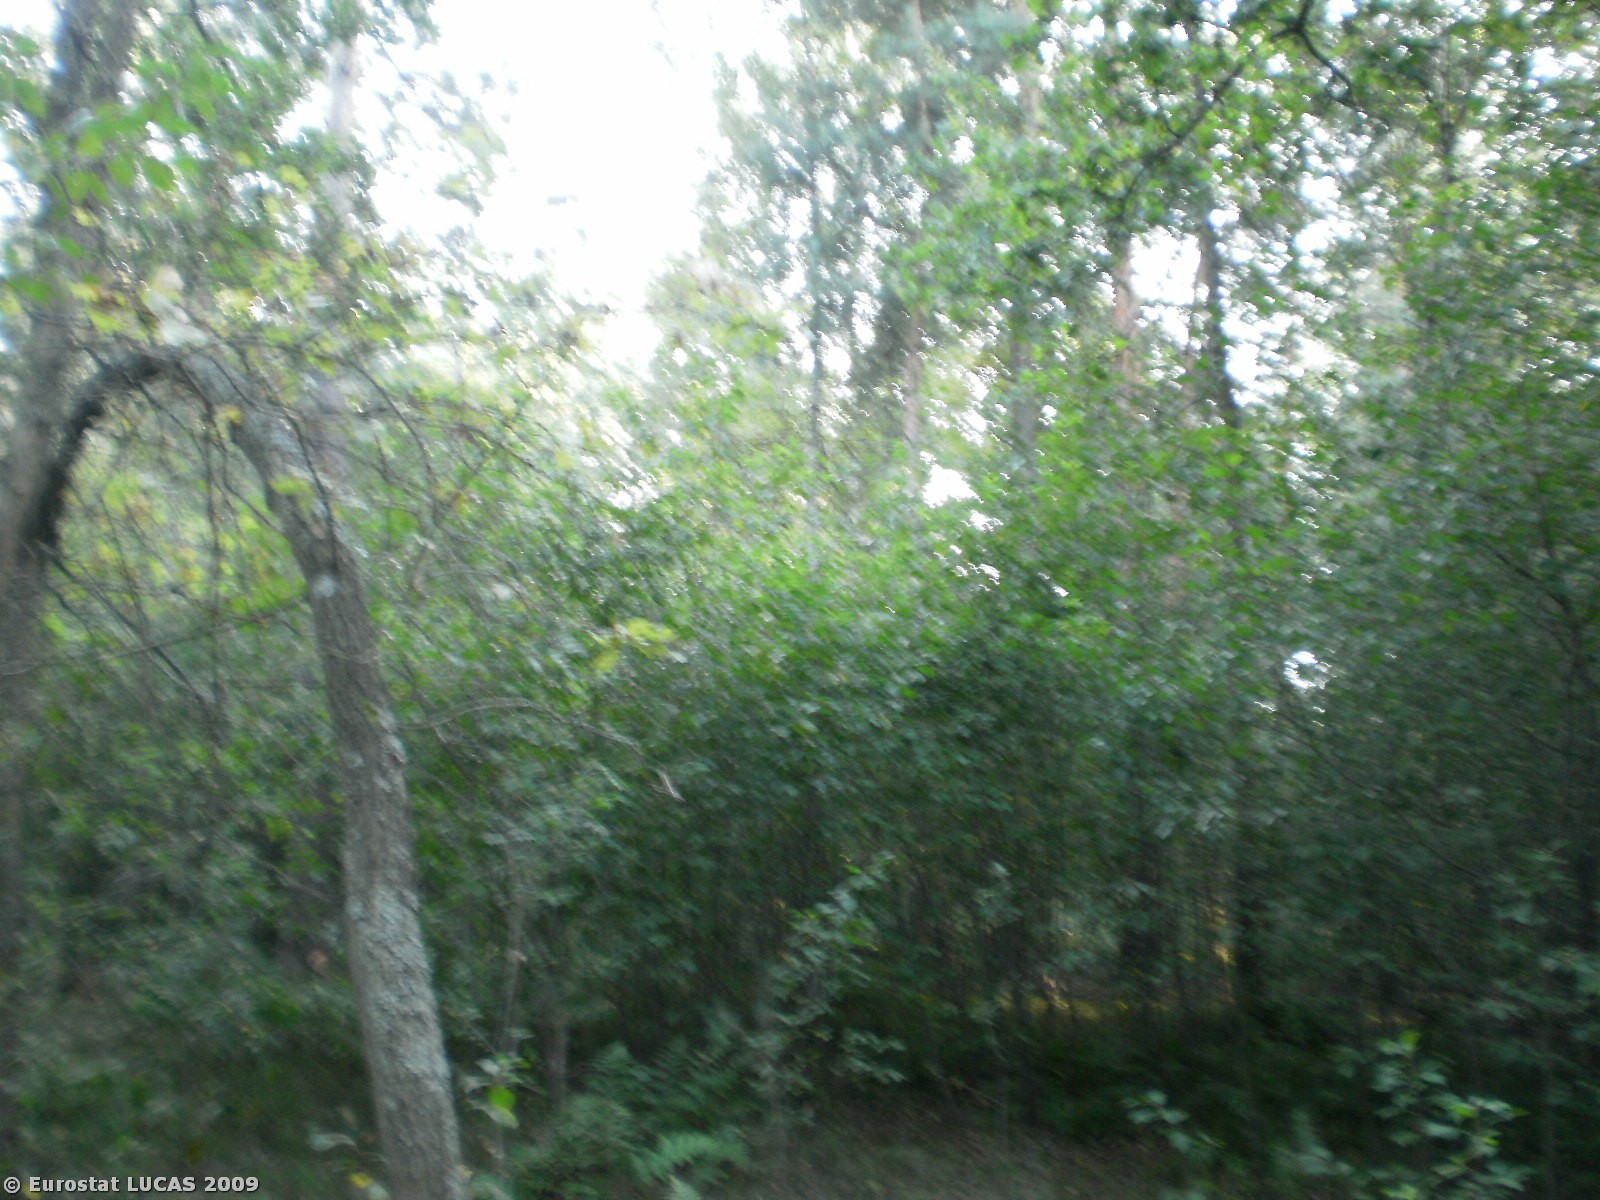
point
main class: Woodland
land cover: Mixed woodland
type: hemiboreal forest and nemoral coniferous forest and mixed broadleaved-coniferous forest
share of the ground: > 75 %
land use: Forestry
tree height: > 5 m
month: August
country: PL
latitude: 52.5783
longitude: 21.6970
